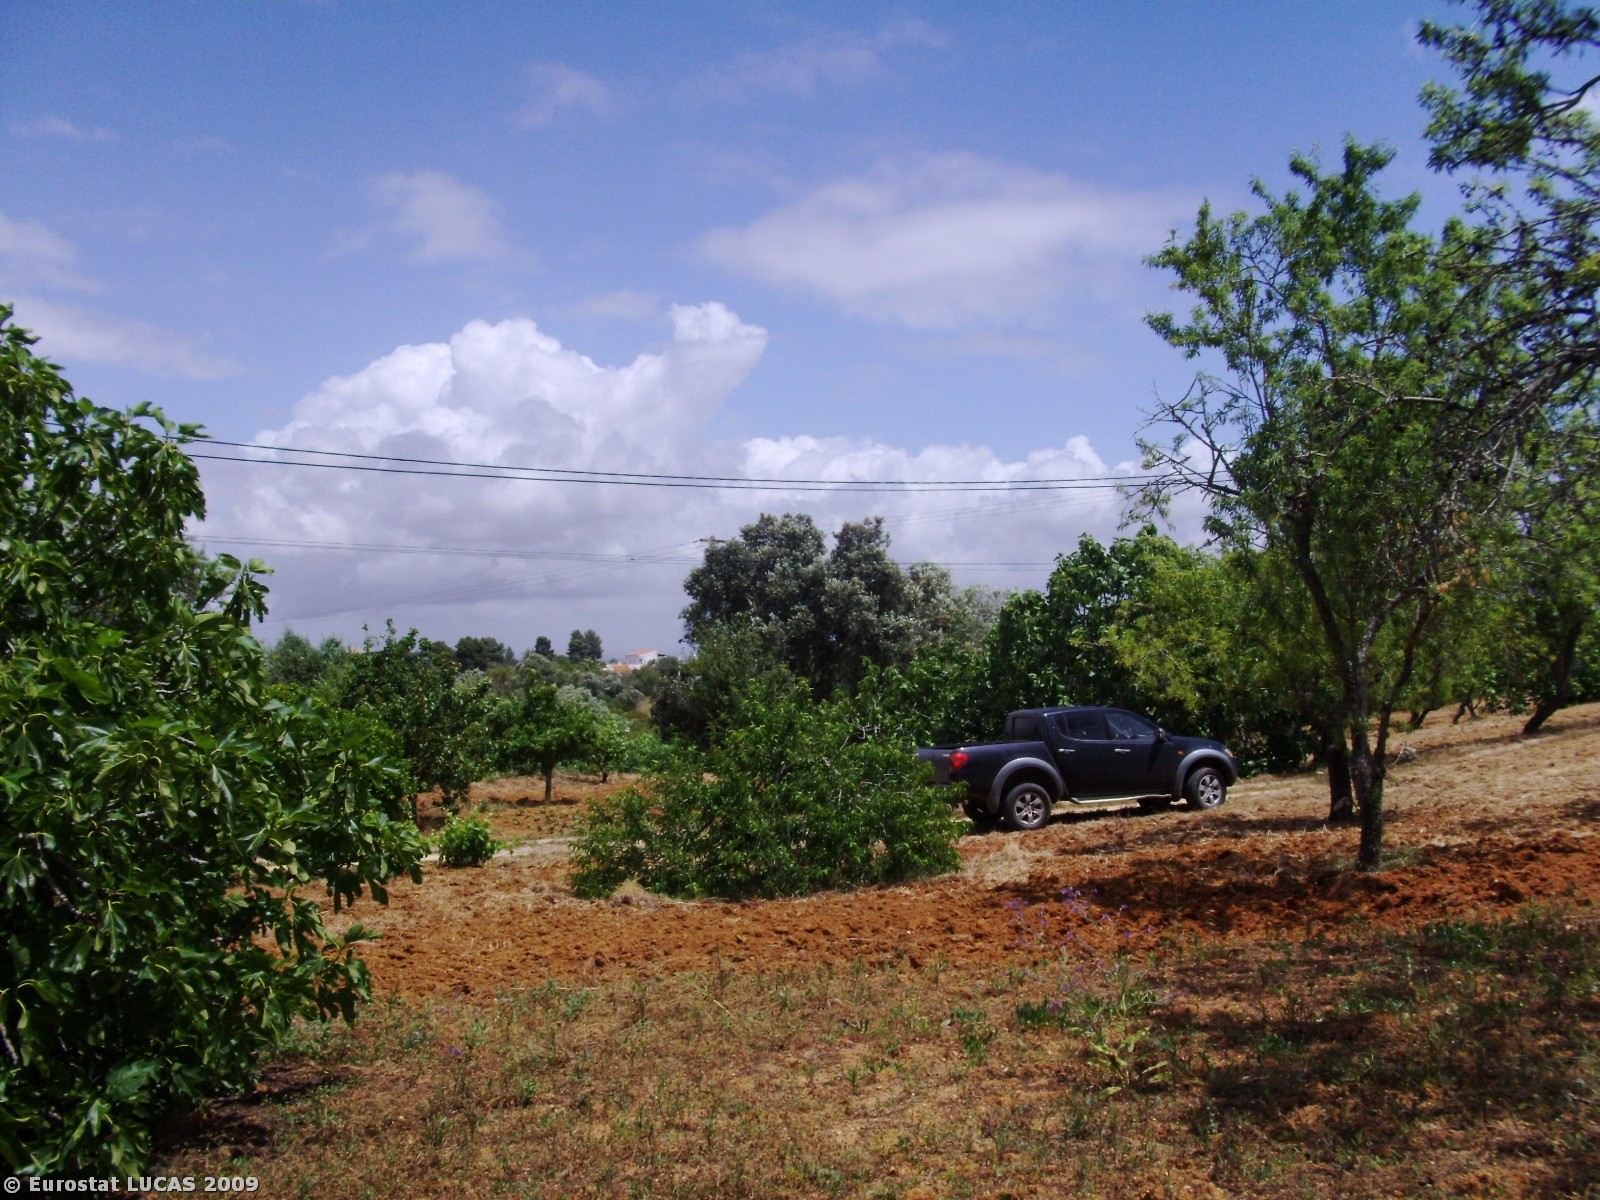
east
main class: Cropland
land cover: Permanent industrial crops
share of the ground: 10 - 25 %
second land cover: Spontaneously vegetated surfaces
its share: 50 - 75 %
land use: Agriculture (excluding fallow land and kitchen gardens)
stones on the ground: 10 - 25 %
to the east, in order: Permanent industrial crops; Spontaneously vegetated surfaces; Nuts trees; Tracks; Permanent industrial crops; Lines of trees; Dry stone walls; Shrubland with sparse tree cover; Tracks; Dry stone walls; Spontaneously vegetated surfaces; Dry stone walls; Spontaneously vegetated surfaces
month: May
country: PT
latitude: 37.1082
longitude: -8.4667
